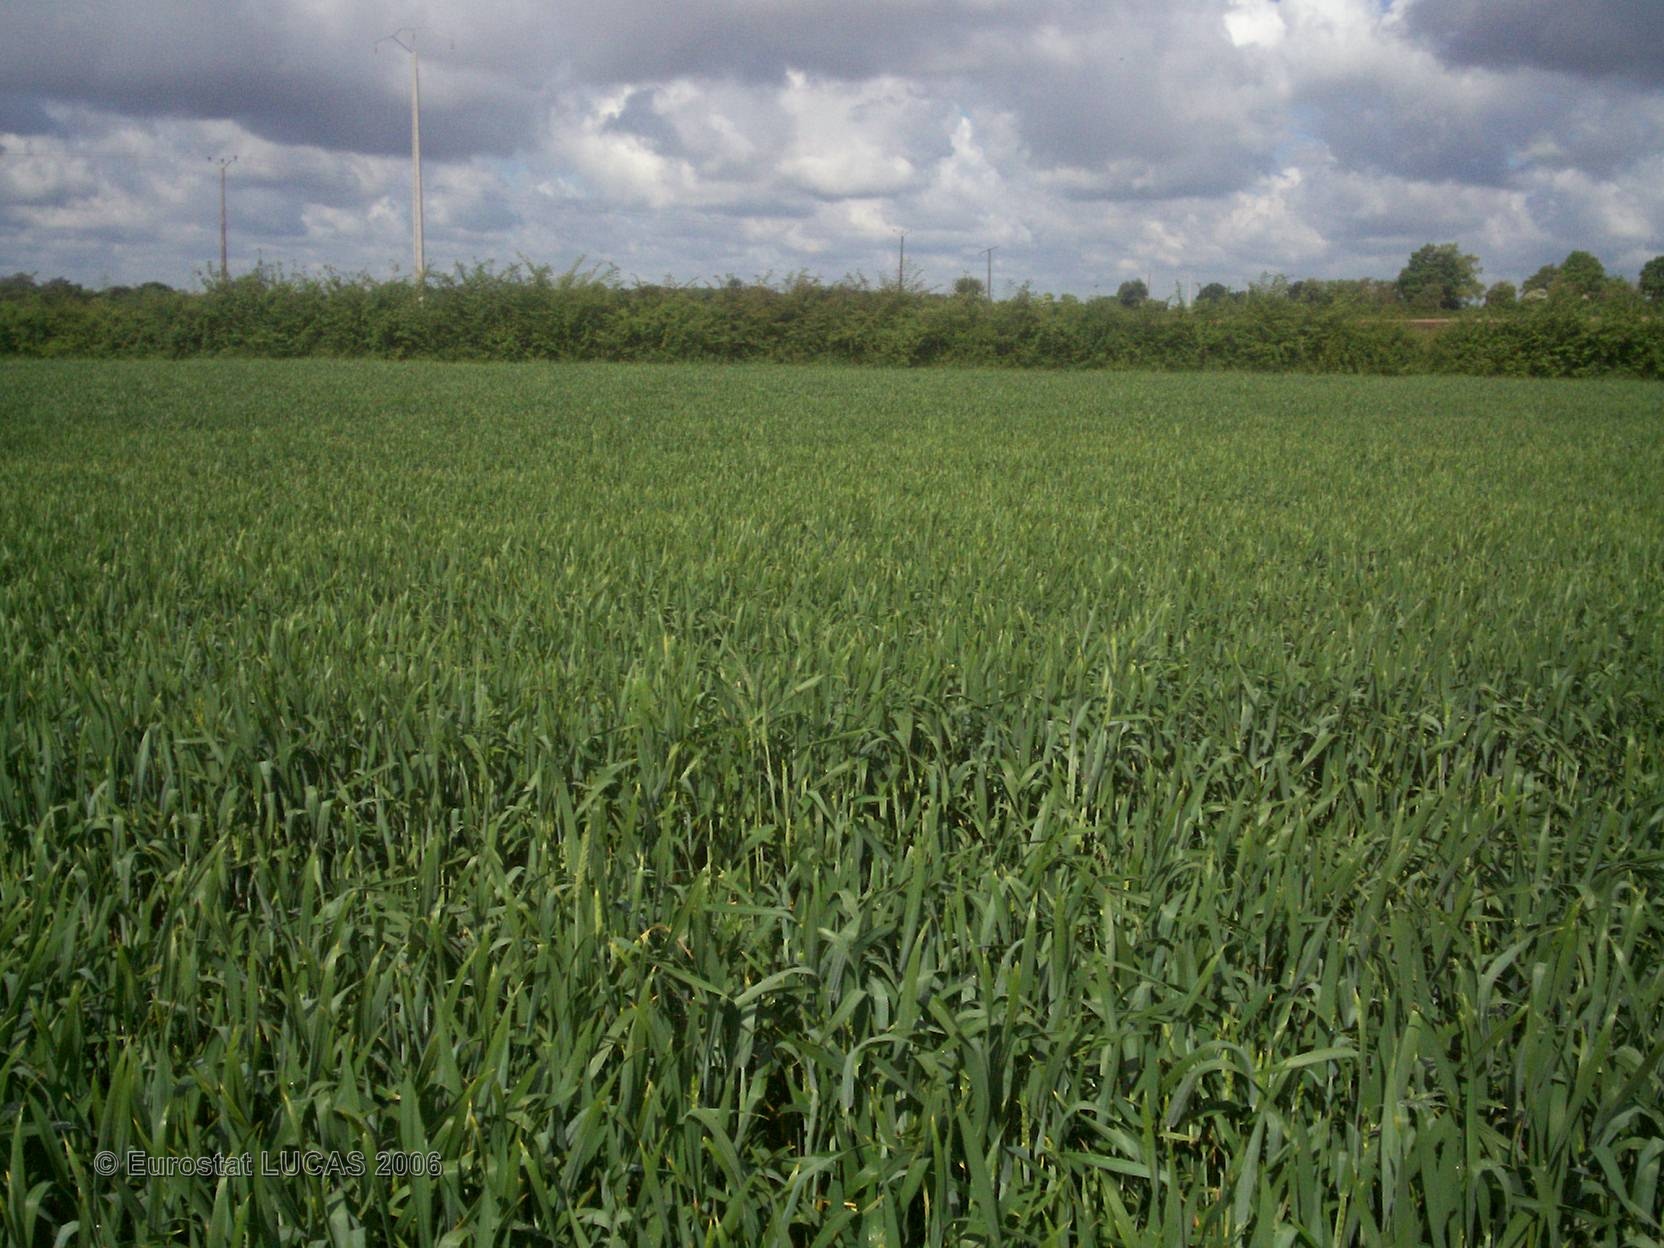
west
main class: Cropland
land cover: Common wheat
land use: Agriculture (excluding fallow land and kitchen gardens)
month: May
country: FR
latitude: 46.3455
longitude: 0.5110
